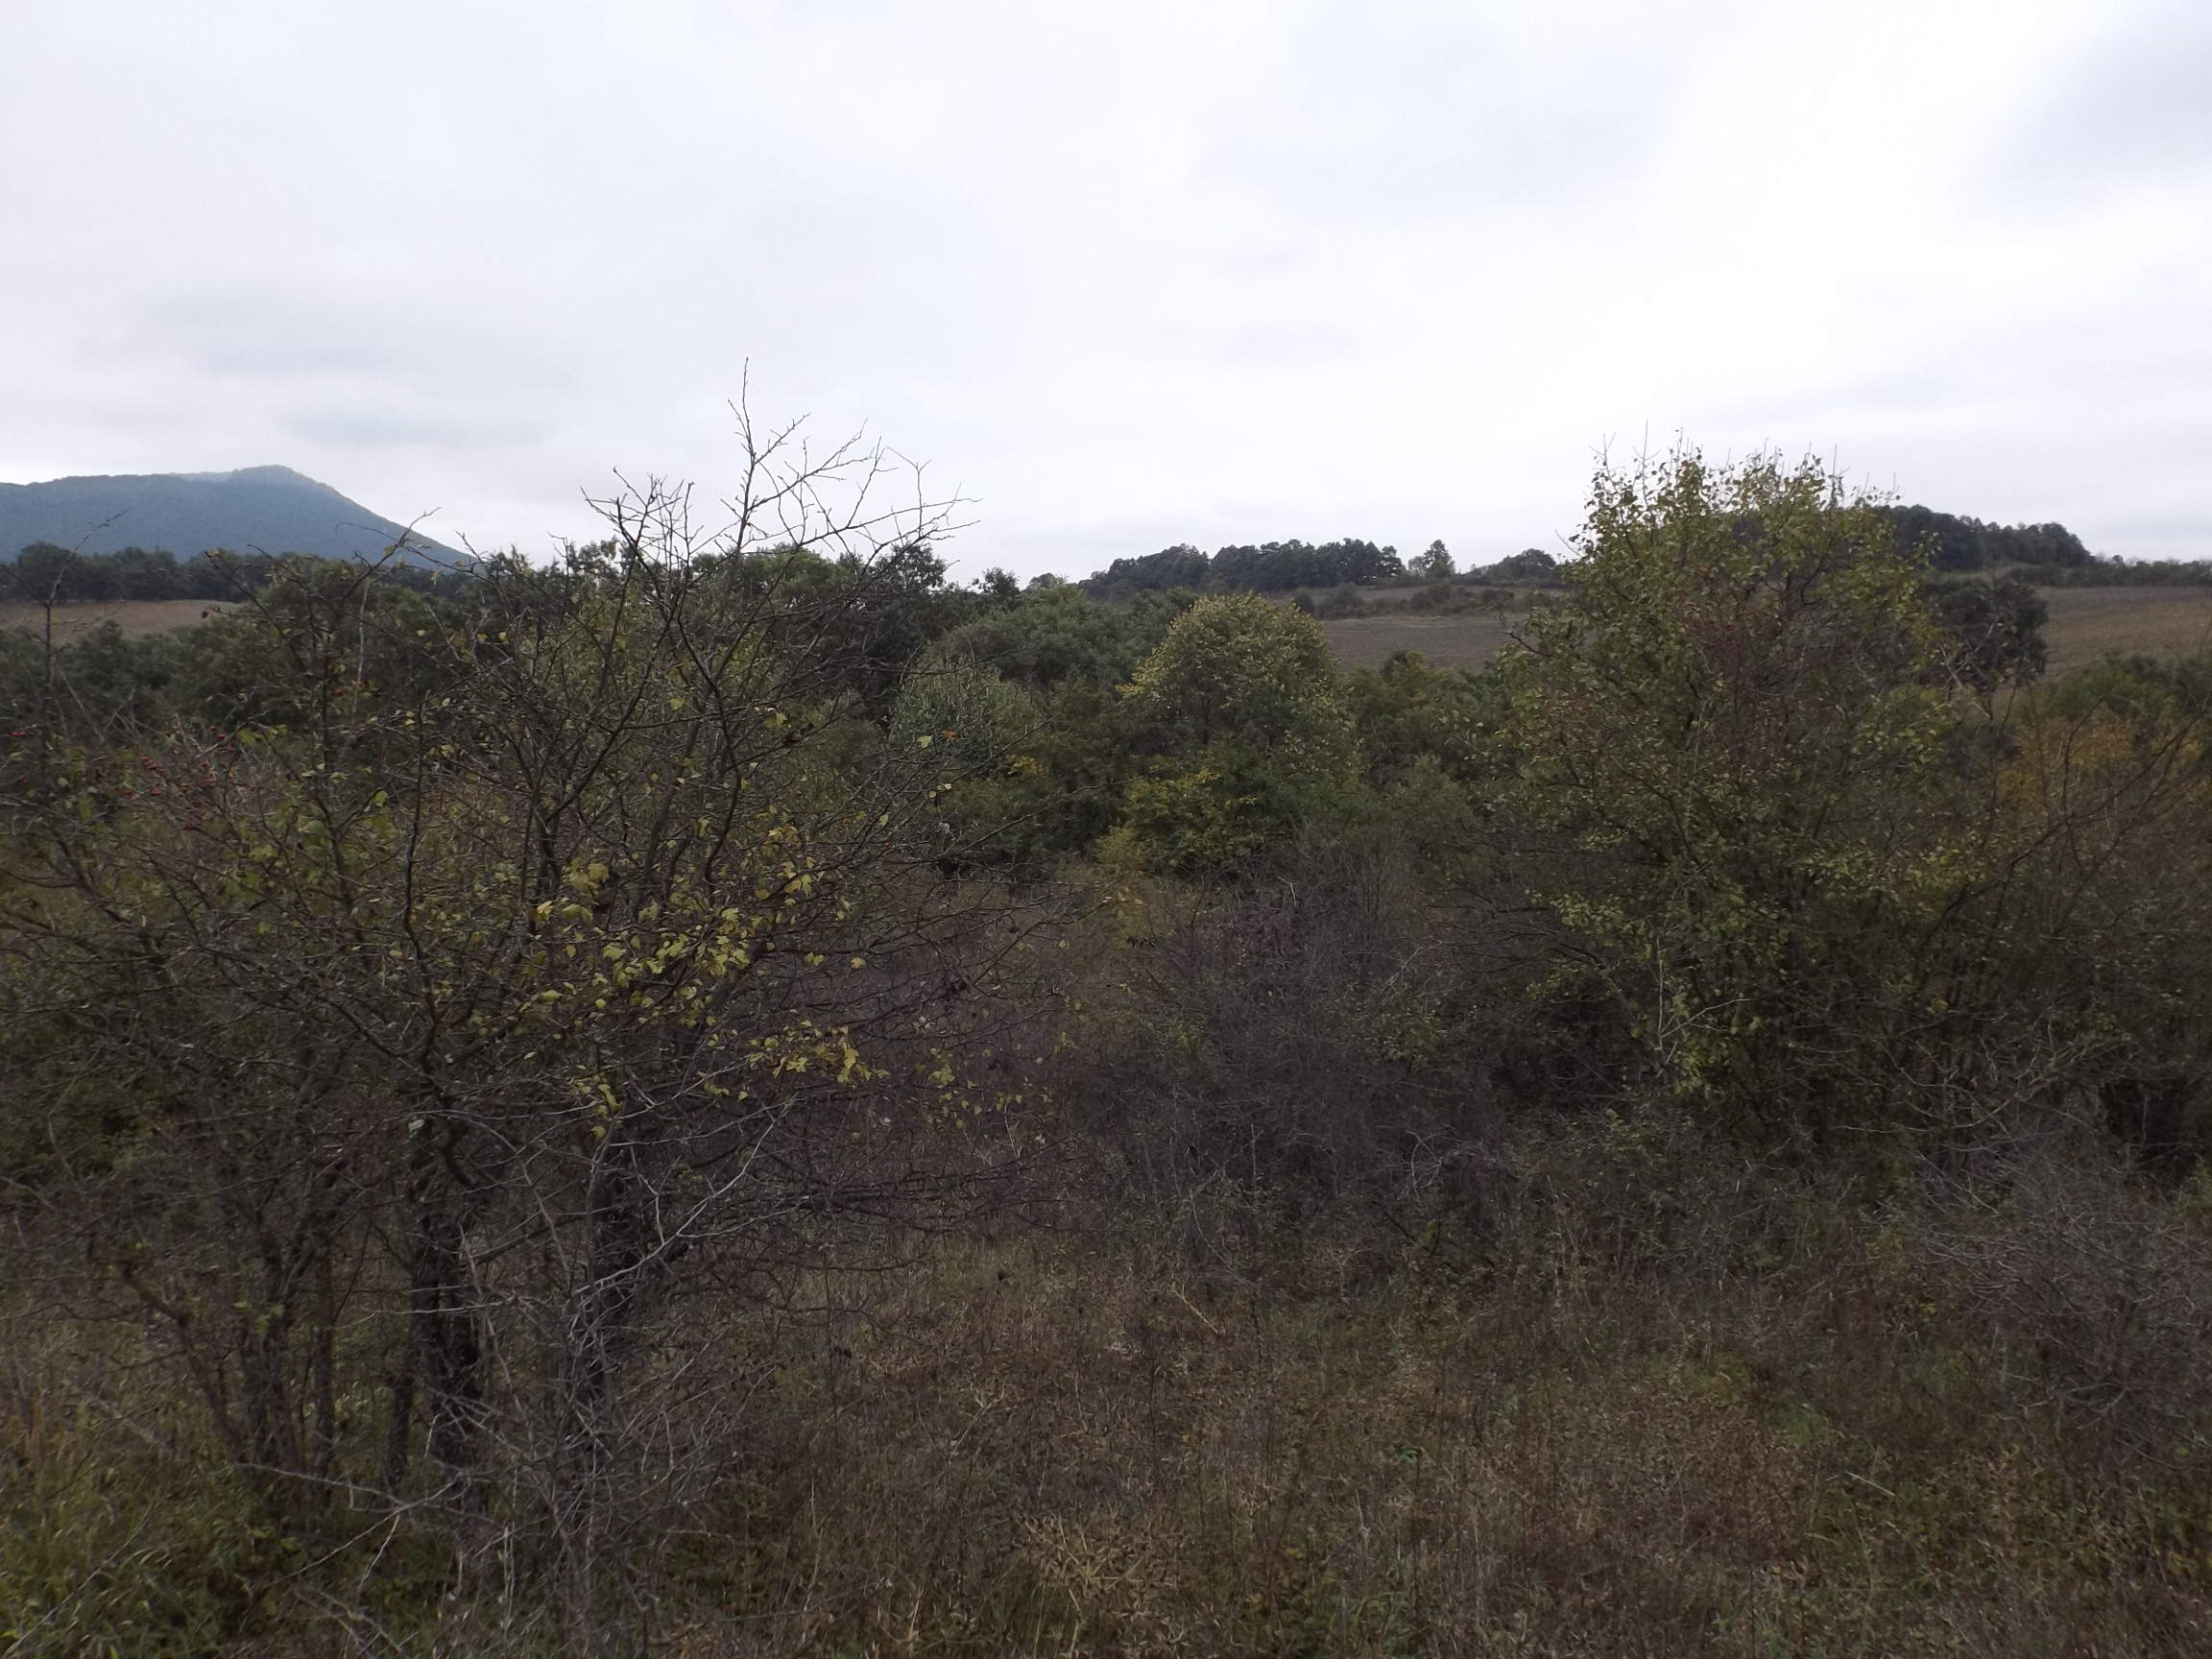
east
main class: Shrubland
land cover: Shrubland with sparse tree cover
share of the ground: 50 - 75 %
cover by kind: shrubs 55 %, herbaceous plants 40 %, broadleaved forest trees 5 %
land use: Semi-natural and natural areas not in use
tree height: > 5 m
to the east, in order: Shrubland with sparse tree cover; Broadleaved woodland; Rivers and streams; Broadleaved woodland; Shrubland with sparse tree cover; Sunflower
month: October
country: BG
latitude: 43.0320
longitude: 27.1884
